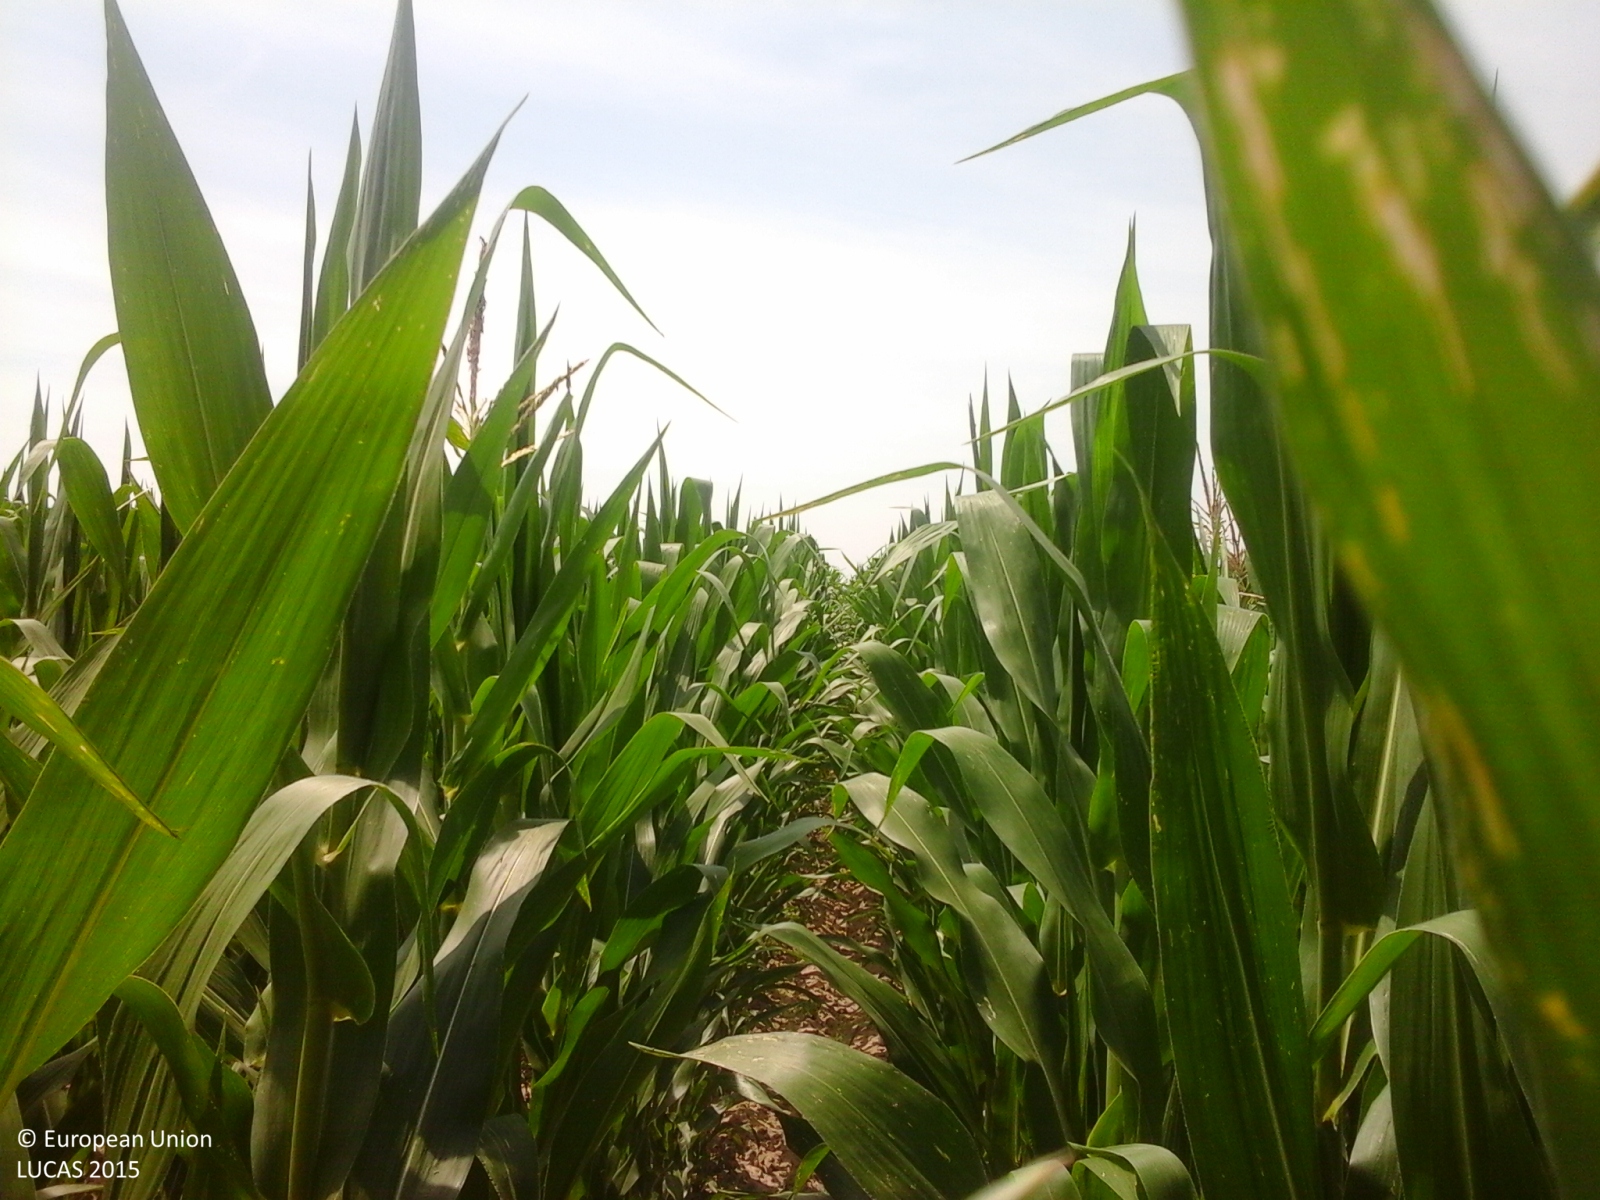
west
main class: Cropland
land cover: Maize
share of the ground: > 75 %
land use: Agriculture (excluding fallow land and kitchen gardens)
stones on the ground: < 10 %
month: June
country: IT
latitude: 44.9928
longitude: 8.7973
